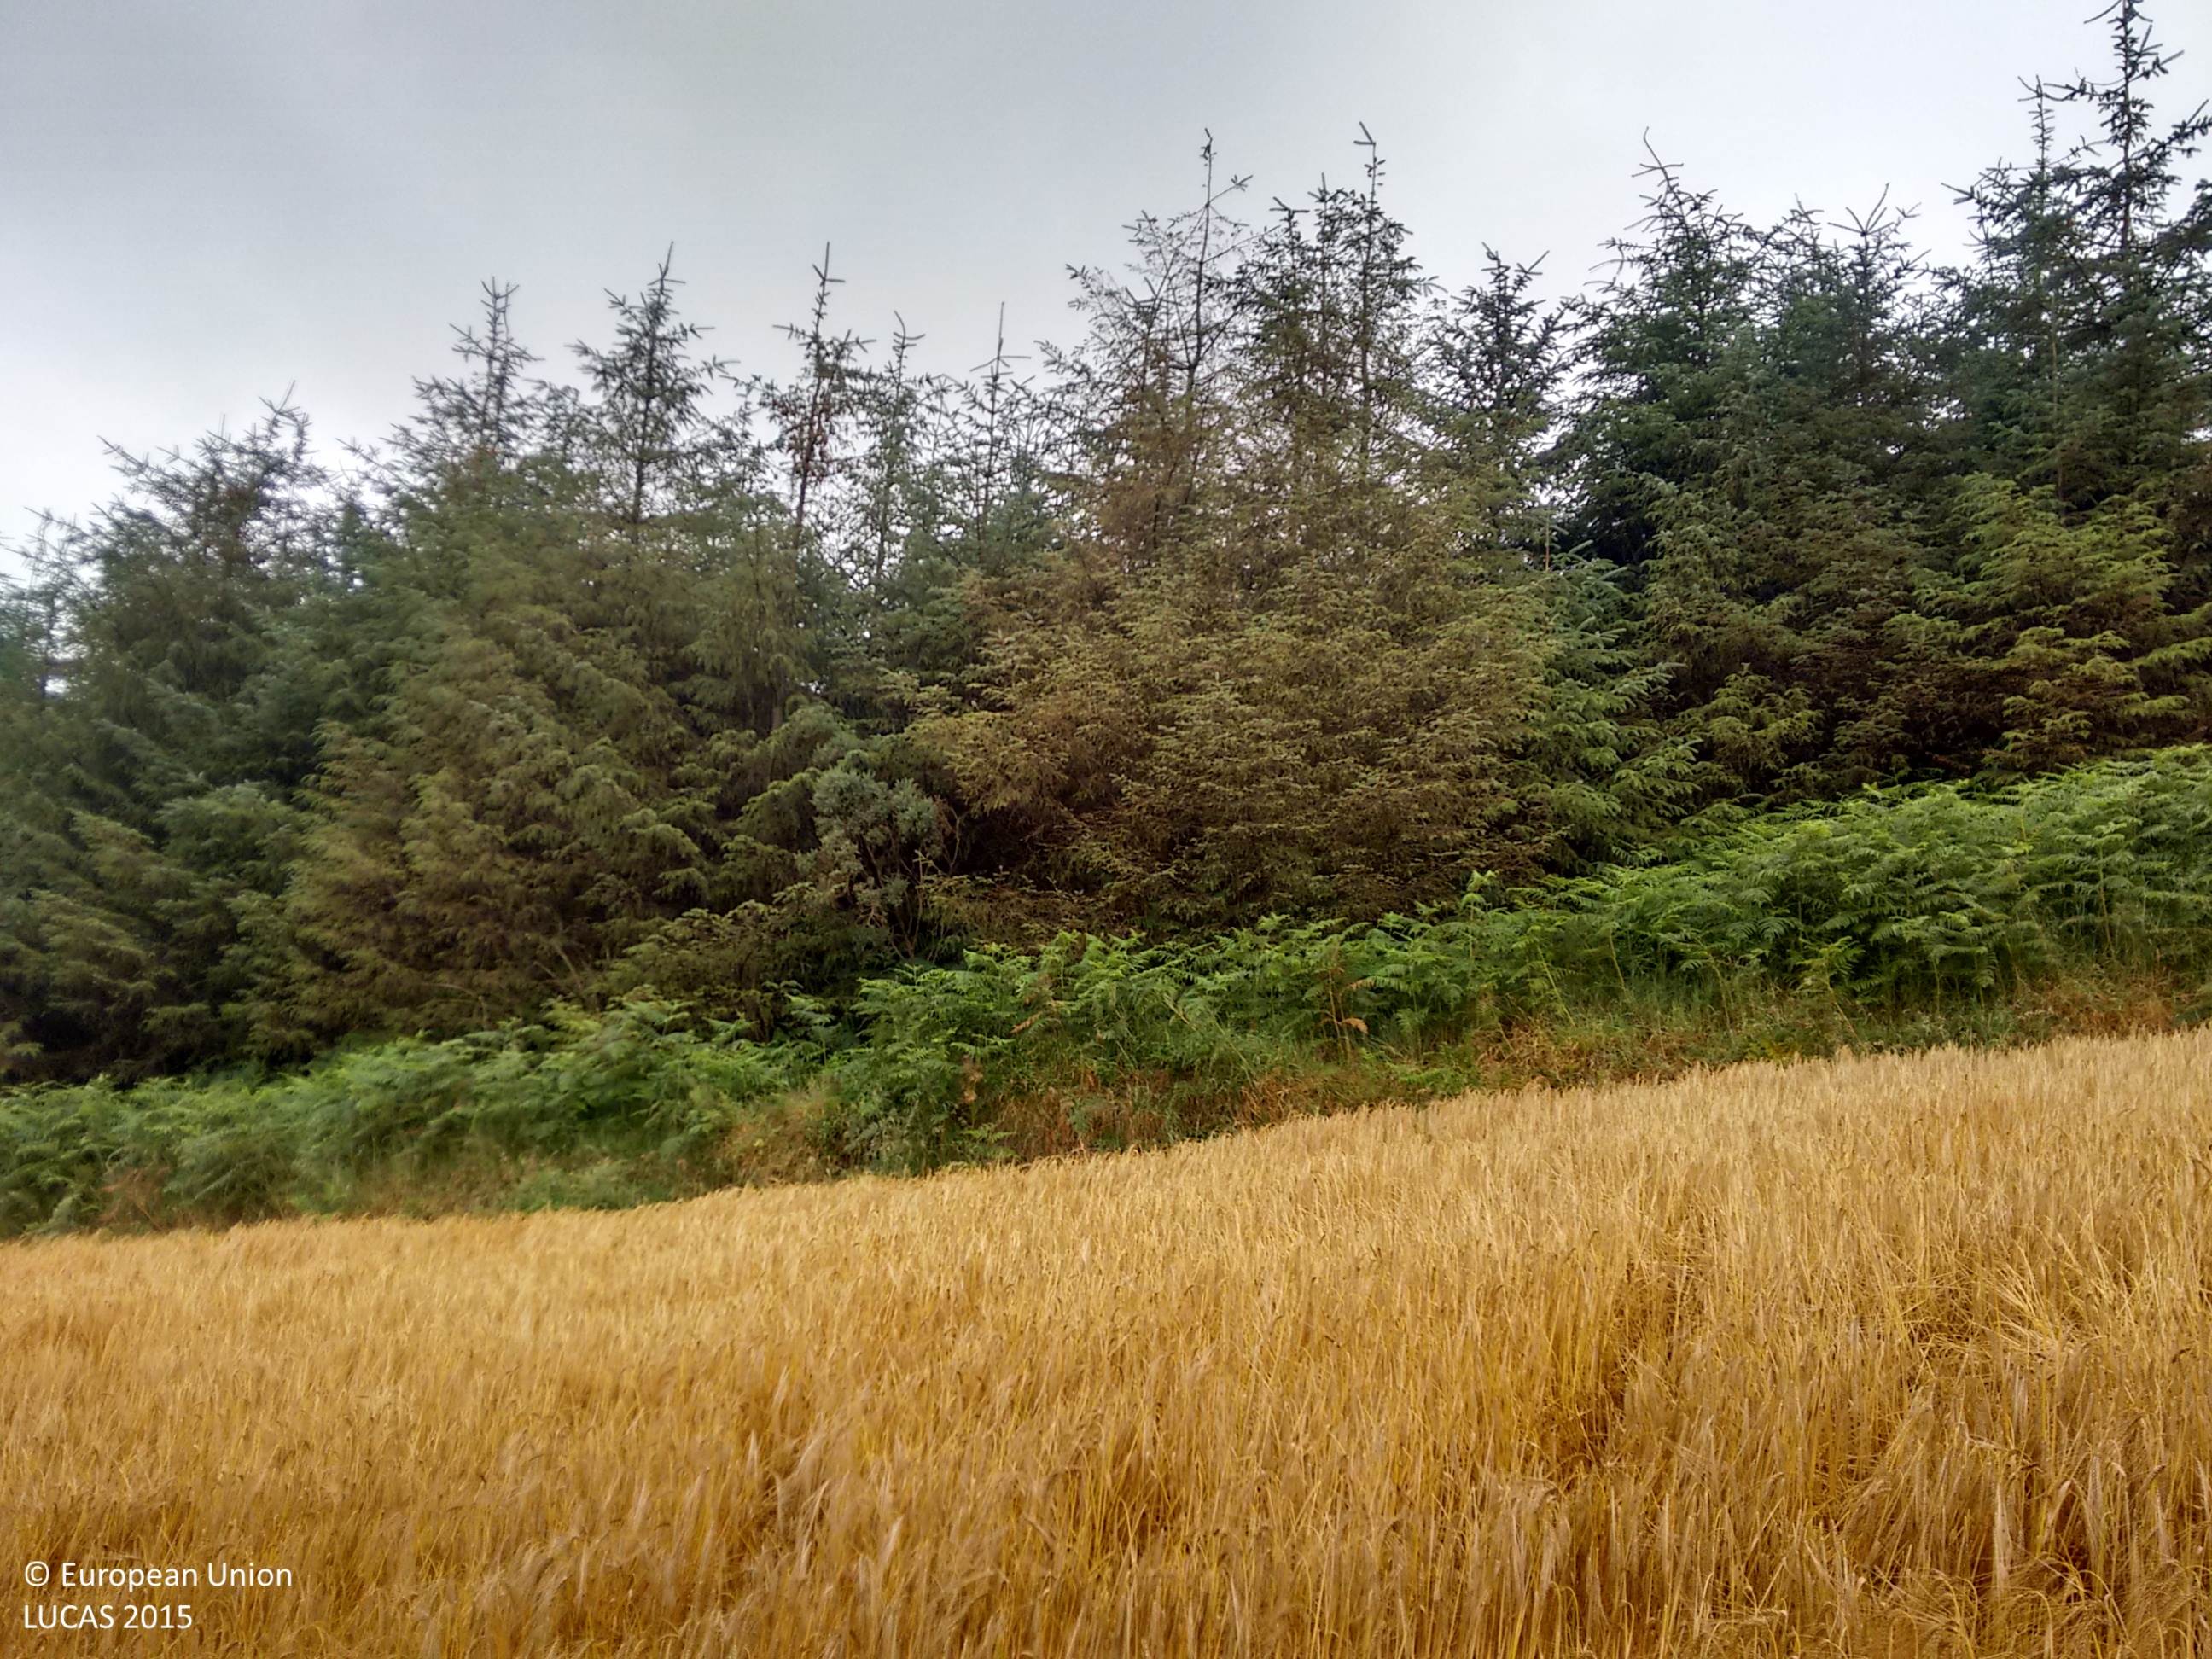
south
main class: Cropland
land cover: Barley
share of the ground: > 75 %
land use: Agriculture (excluding fallow land and kitchen gardens)
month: August
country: IE
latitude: 52.6930
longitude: -6.4152
